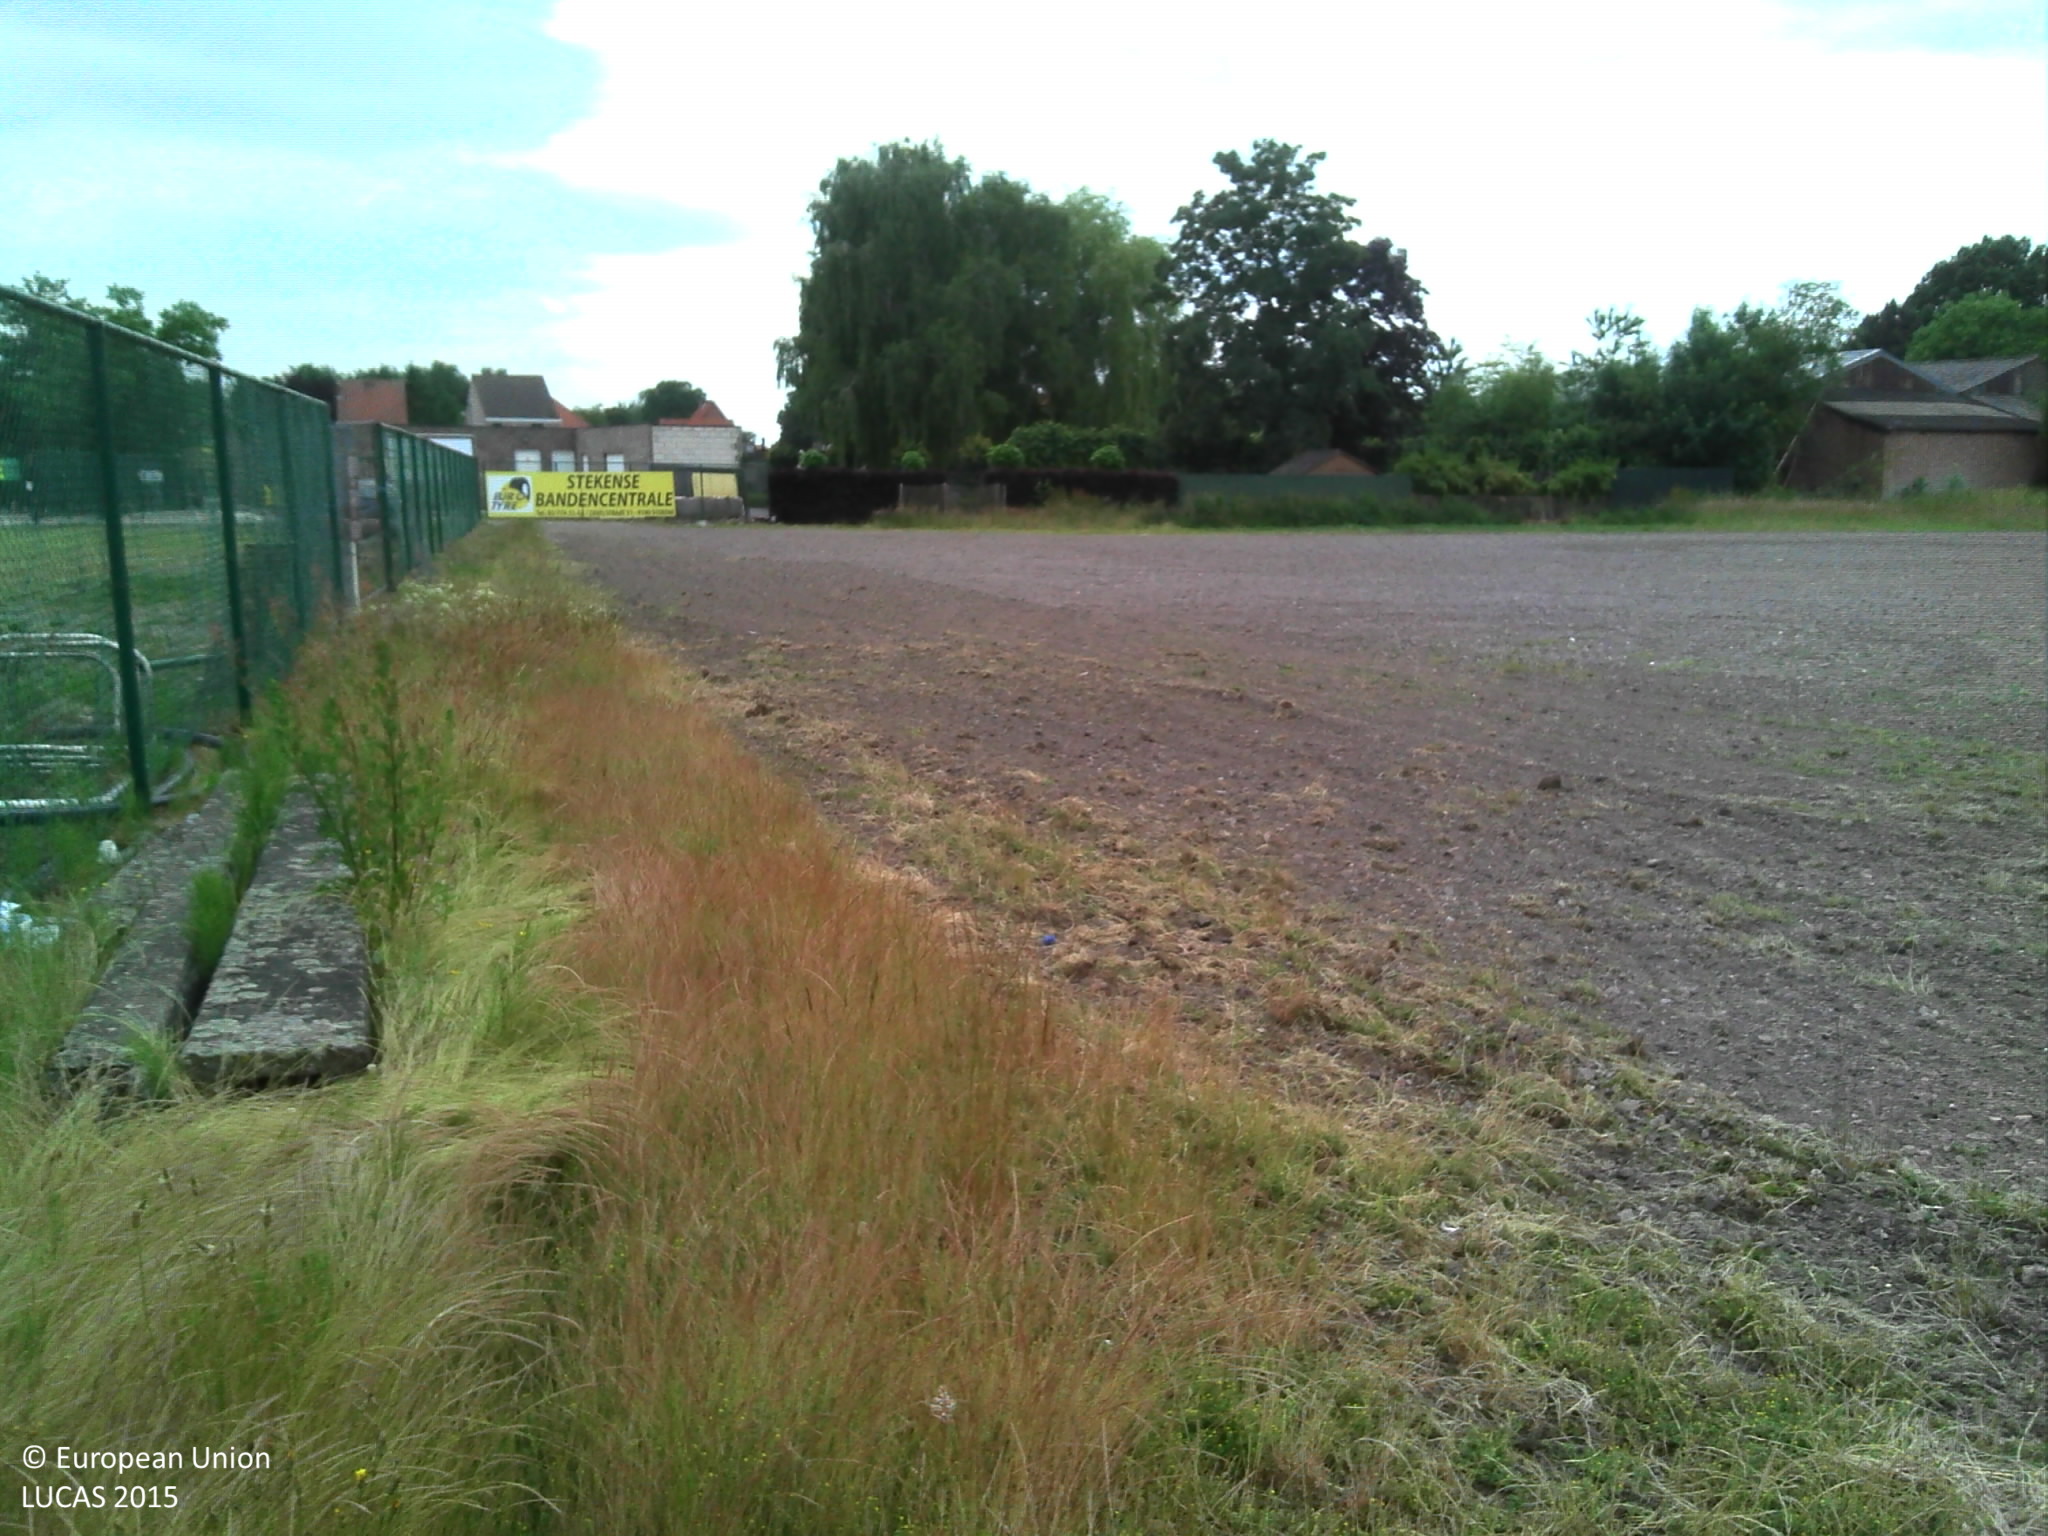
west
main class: Grassland
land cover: Grassland without tree/shrub cover
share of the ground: > 75 %
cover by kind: herbaceous plants 100 %
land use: Sport
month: June
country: BE
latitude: 51.2175
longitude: 4.0241
